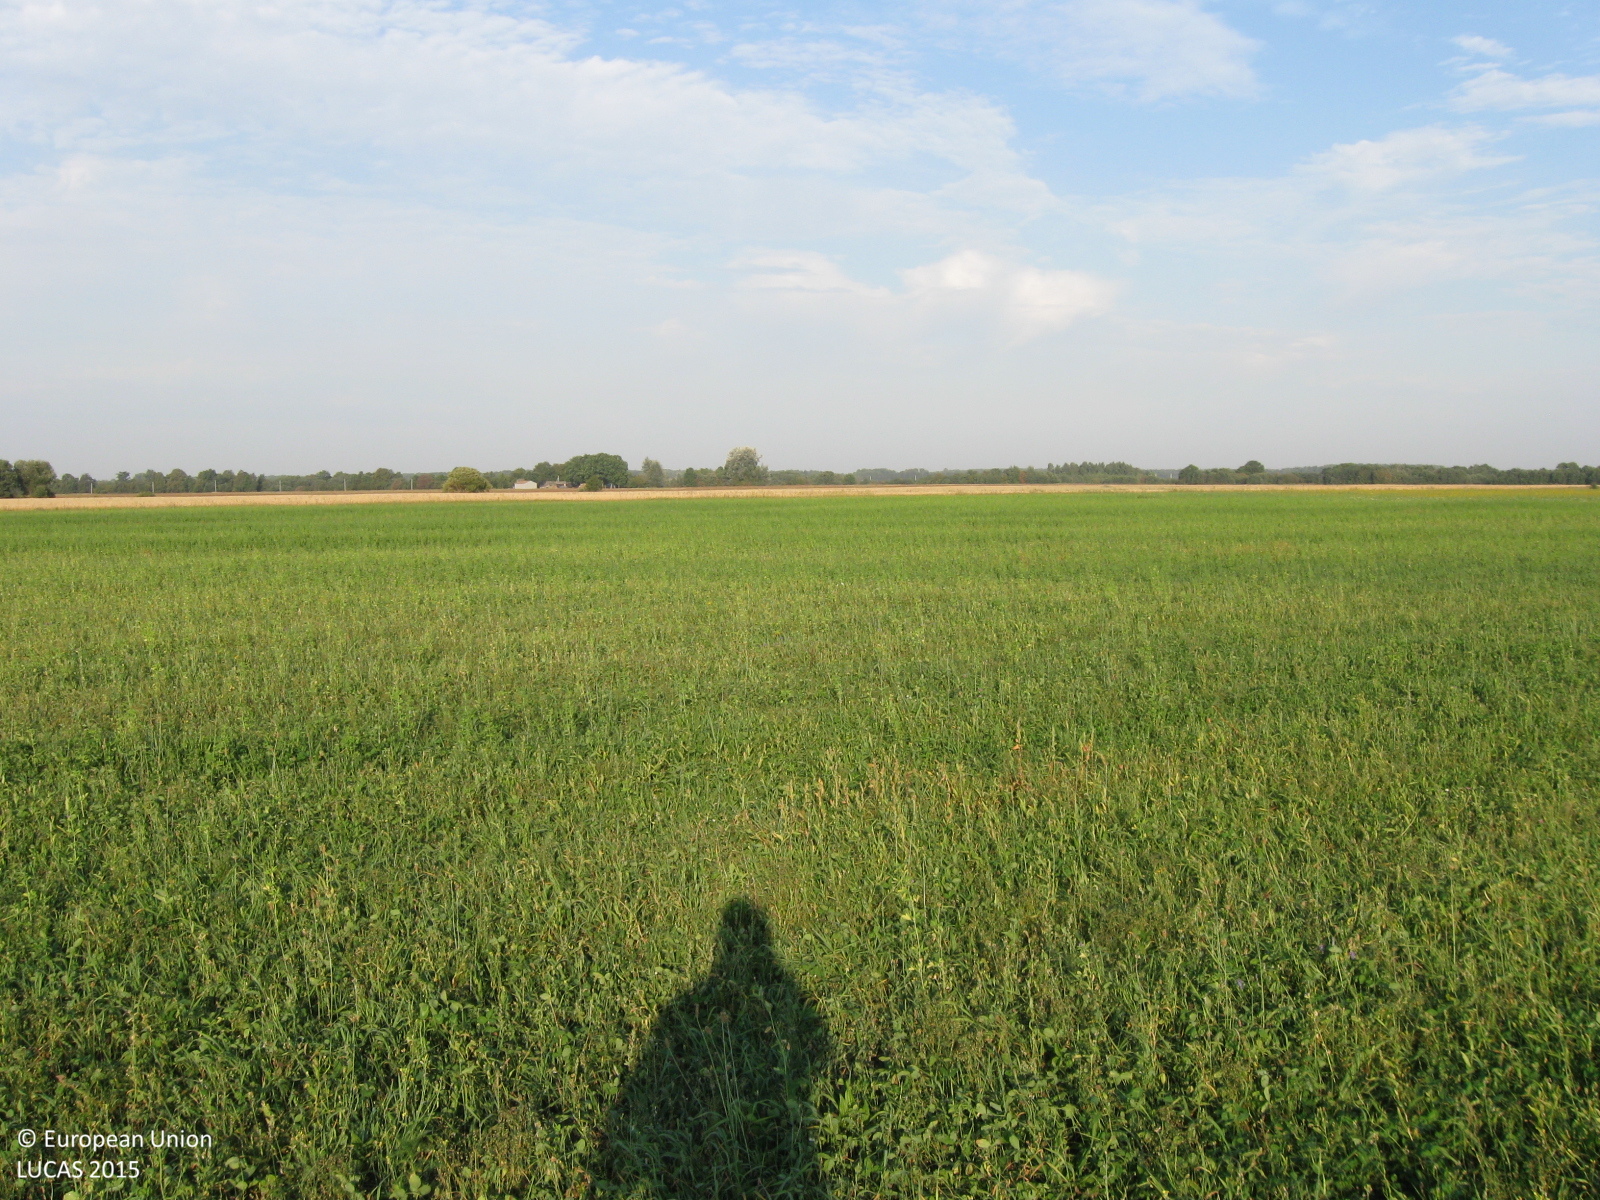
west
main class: Cropland
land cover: Other leguminous and mixtures for fodder
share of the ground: > 75 %
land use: Agriculture (excluding fallow land and kitchen gardens)
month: August
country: LT
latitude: 55.3581
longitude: 22.8282
